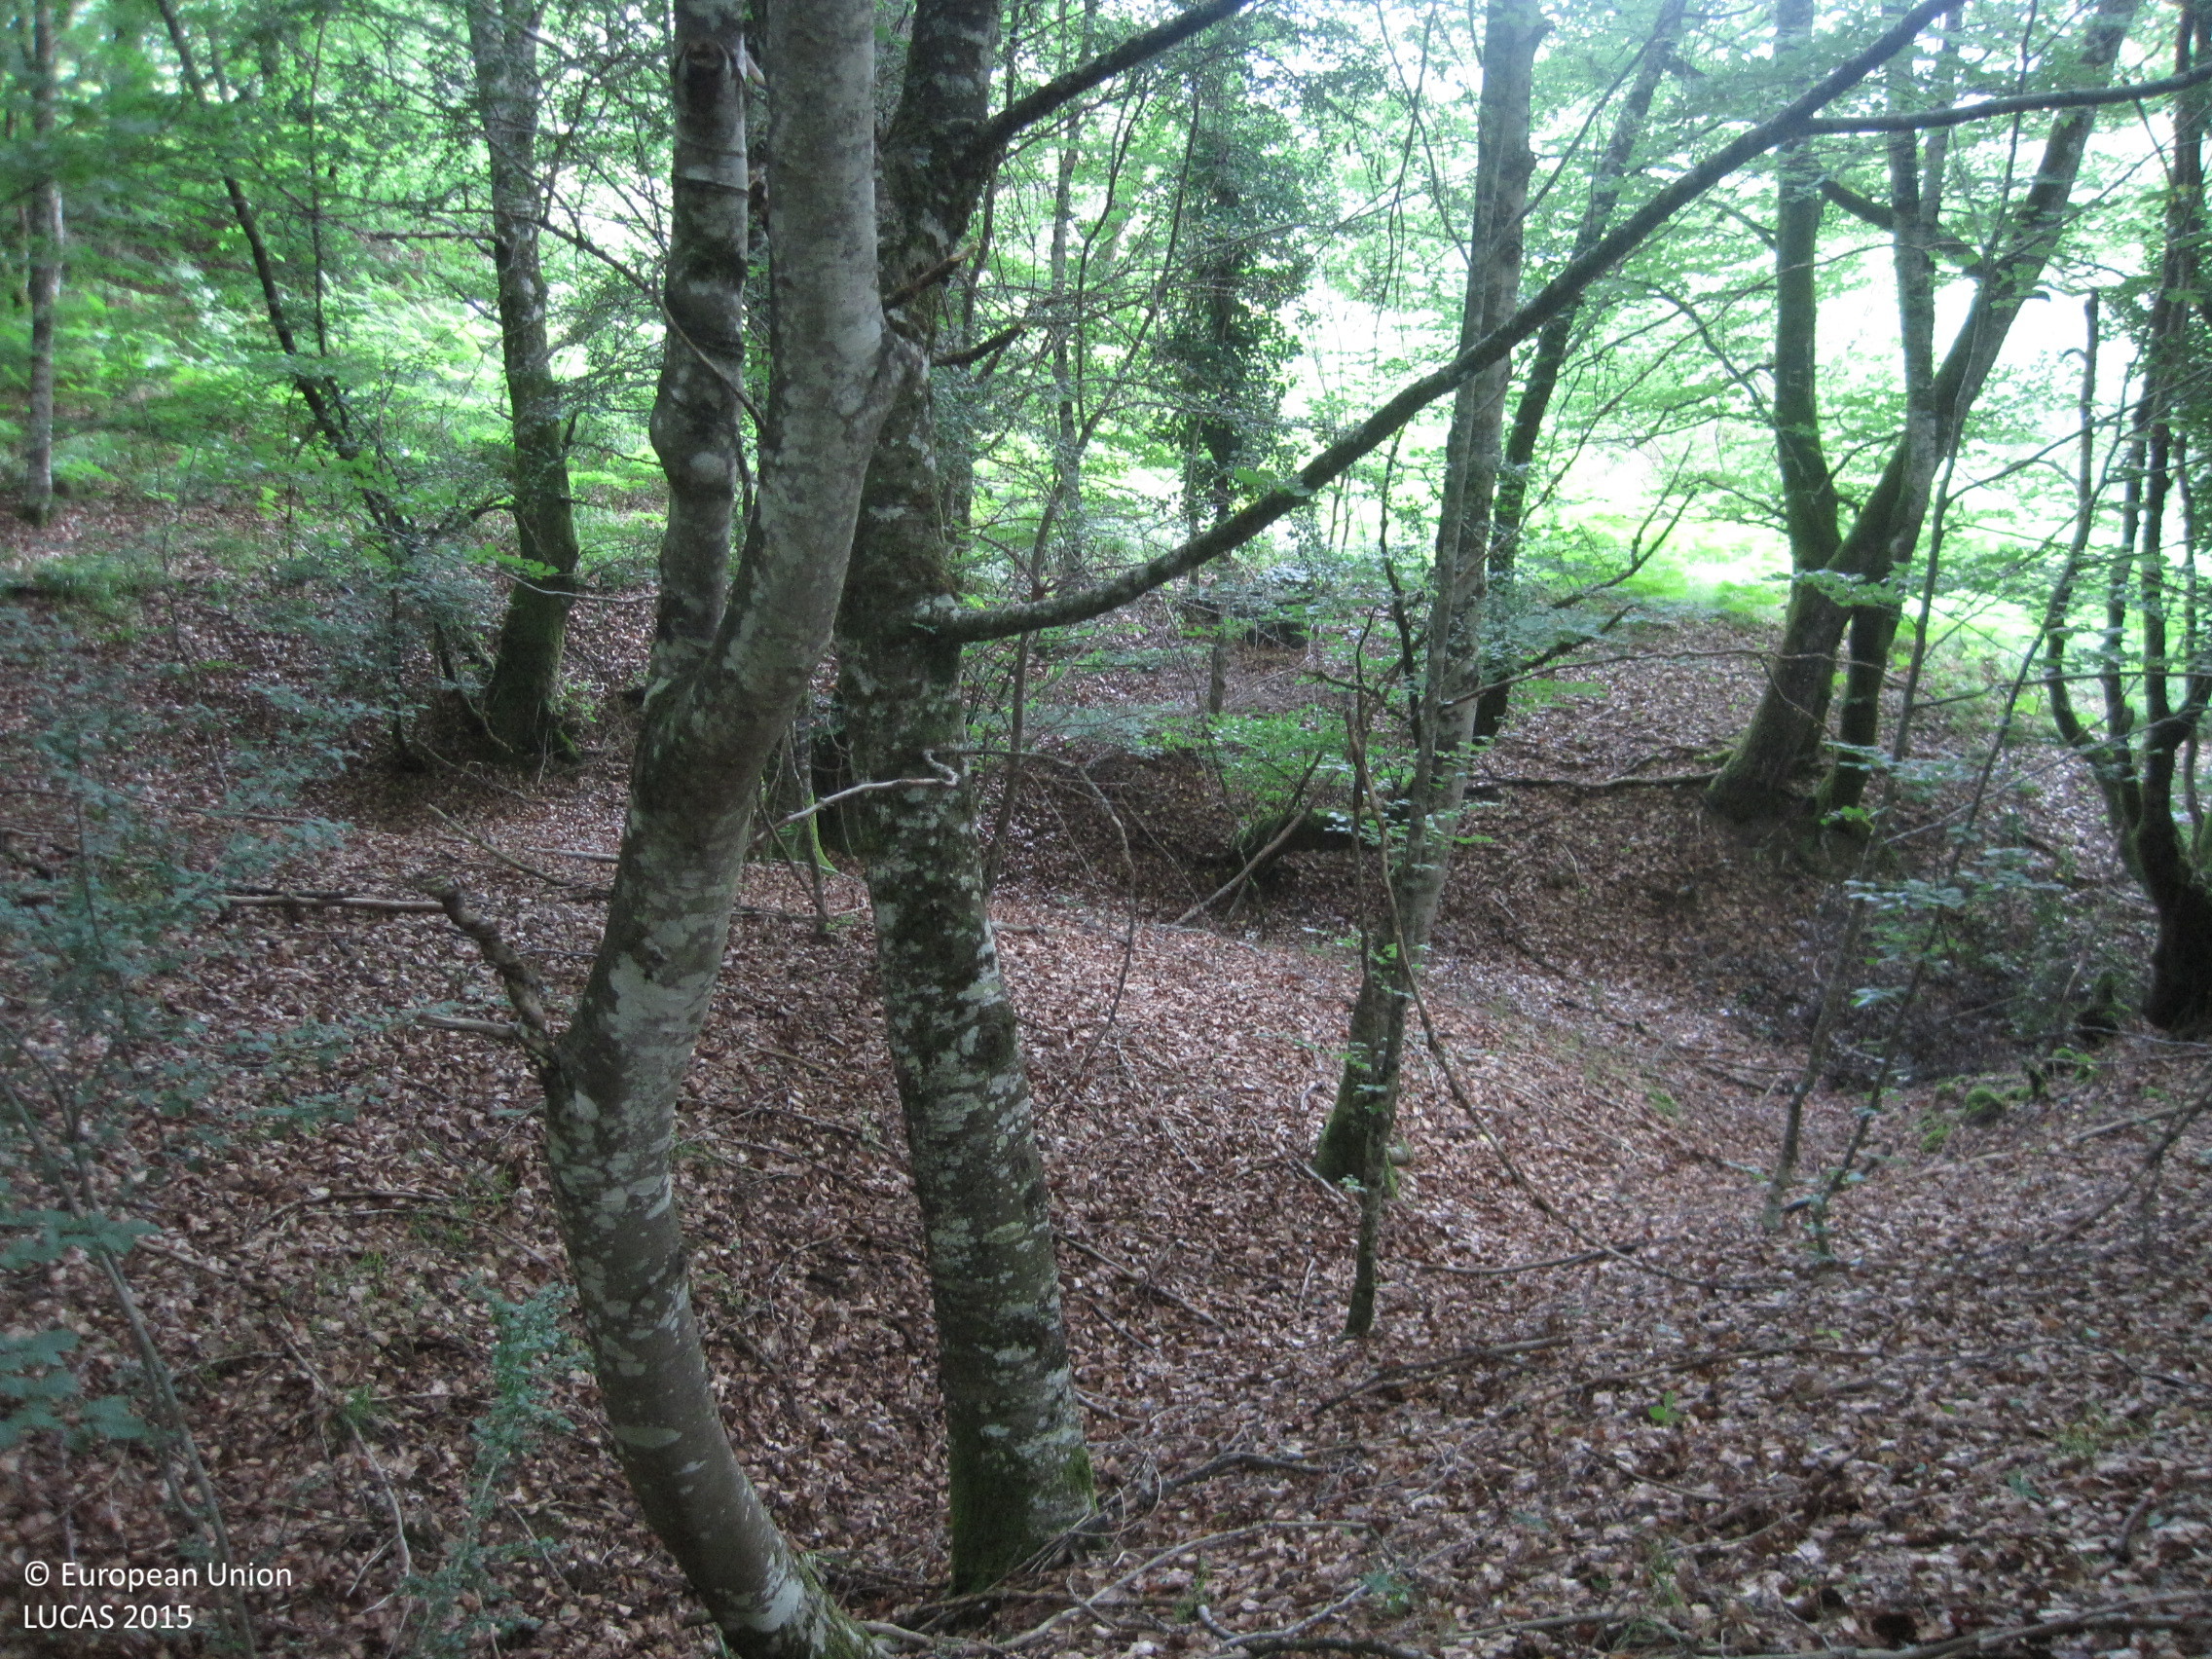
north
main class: Woodland
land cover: Broadleaved woodland
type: beech forest
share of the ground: > 75 %
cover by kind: broadleaved forest trees 100 %
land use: Forestry
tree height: > 5 m
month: June
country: ES
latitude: 43.0000
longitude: -1.8062
